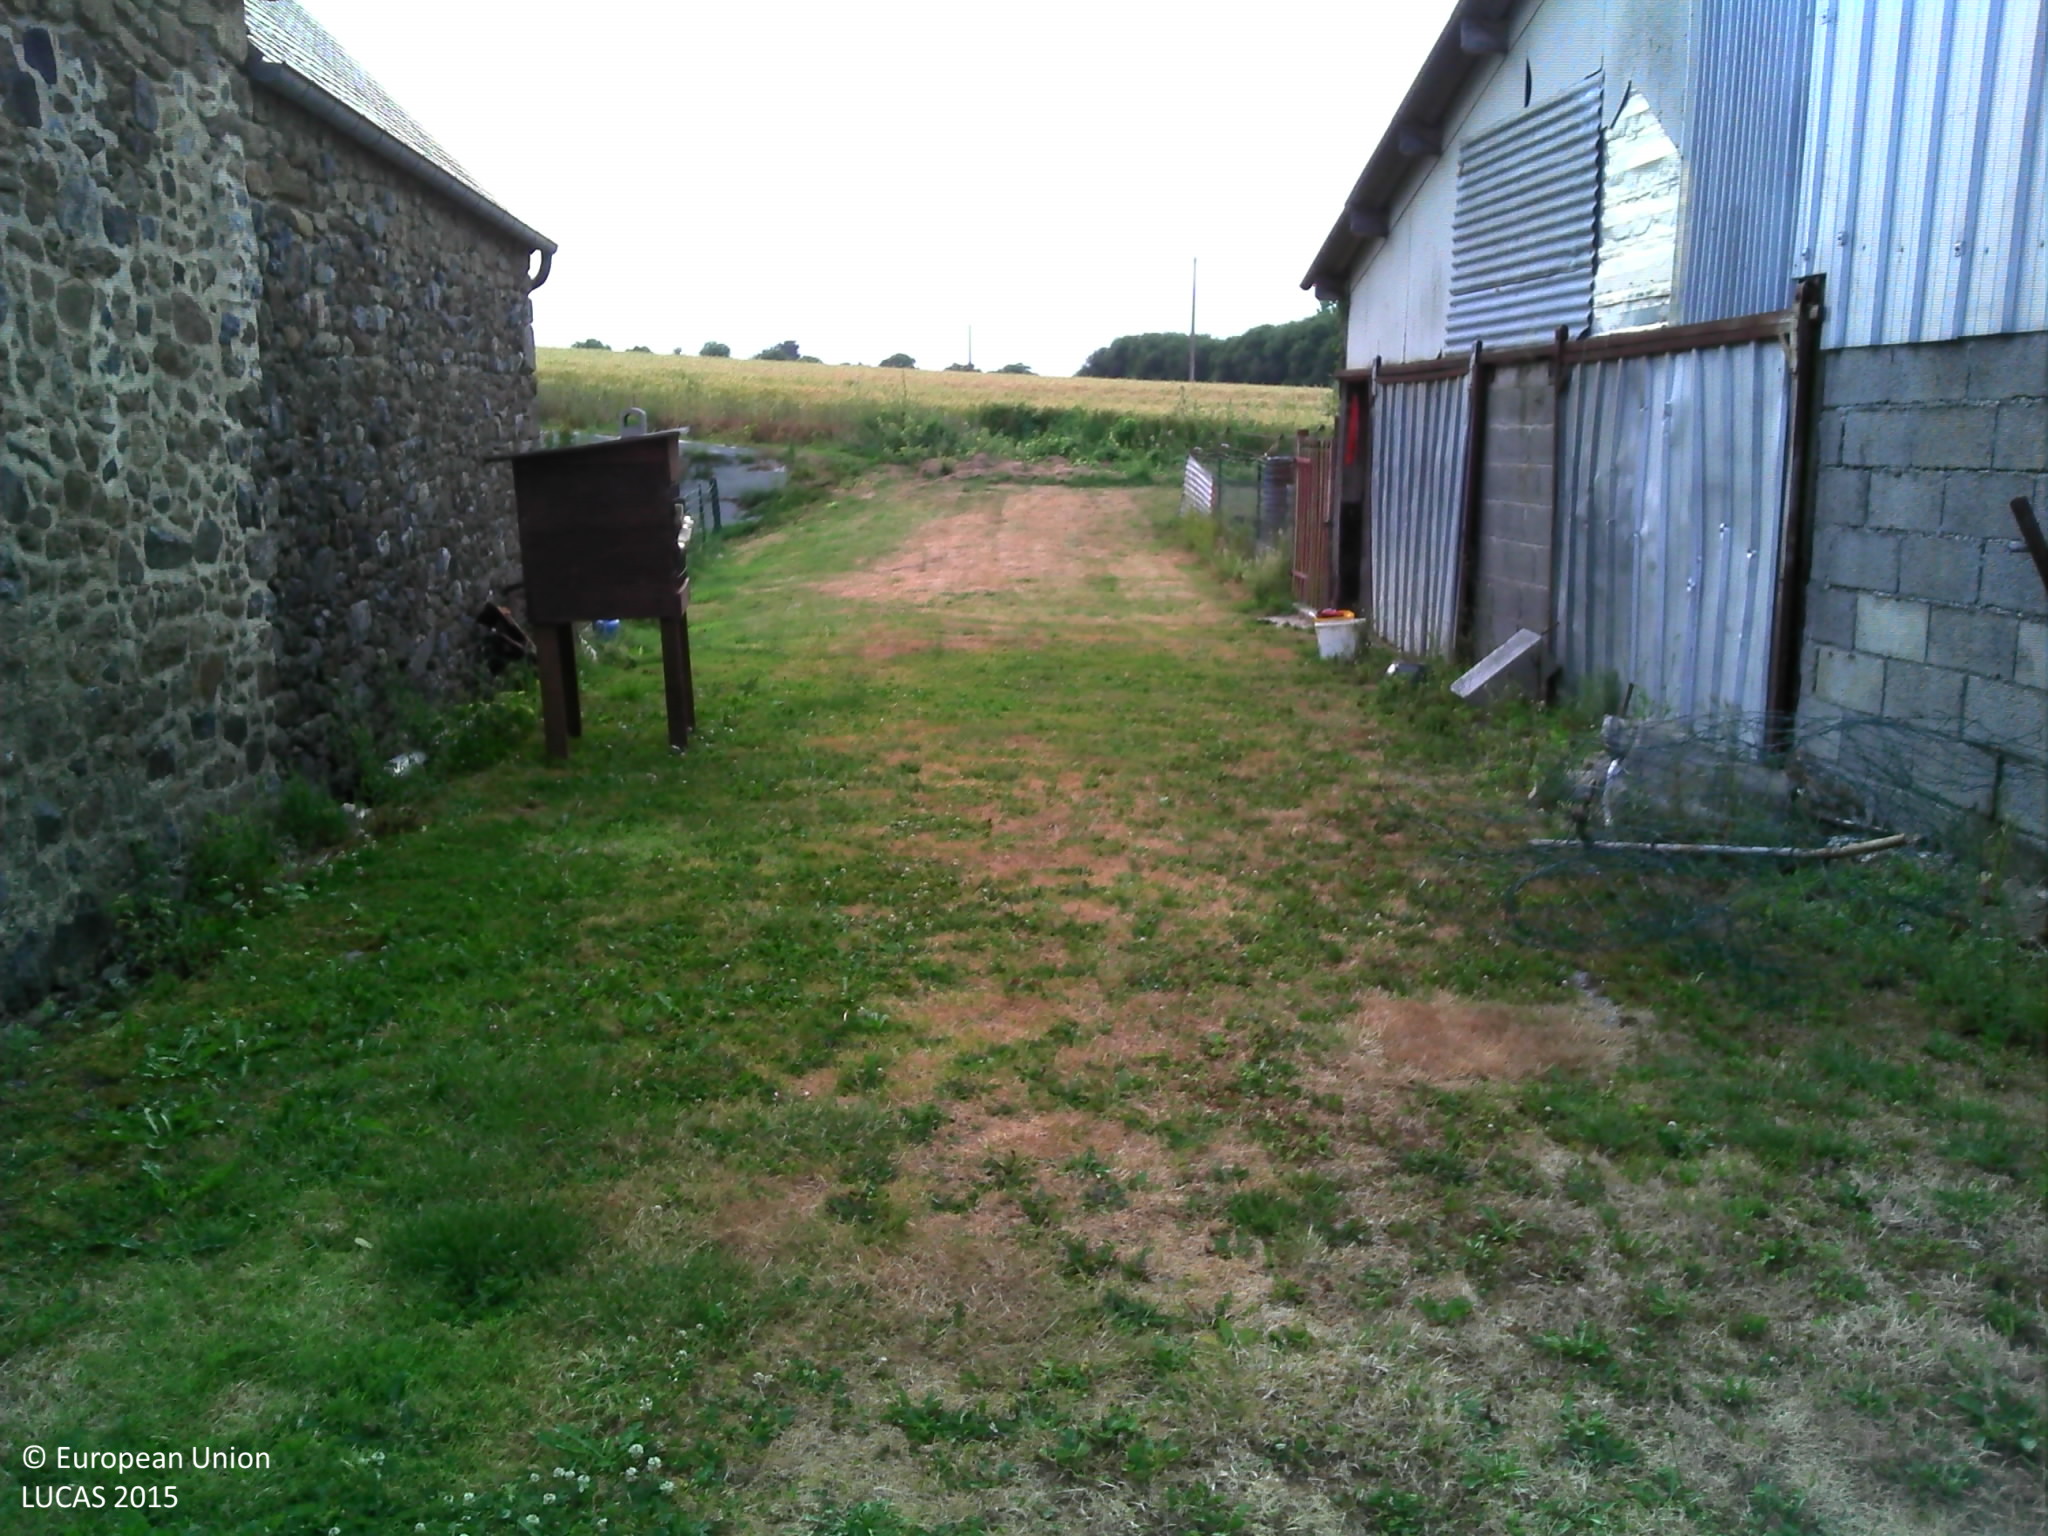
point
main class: Grassland
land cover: Grassland without tree/shrub cover
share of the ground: > 75 %
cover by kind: herbaceous plants 85 %, unconsolidated bare surface 15 %
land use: Residential
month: July
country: FR
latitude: 48.5459
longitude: -2.1805
